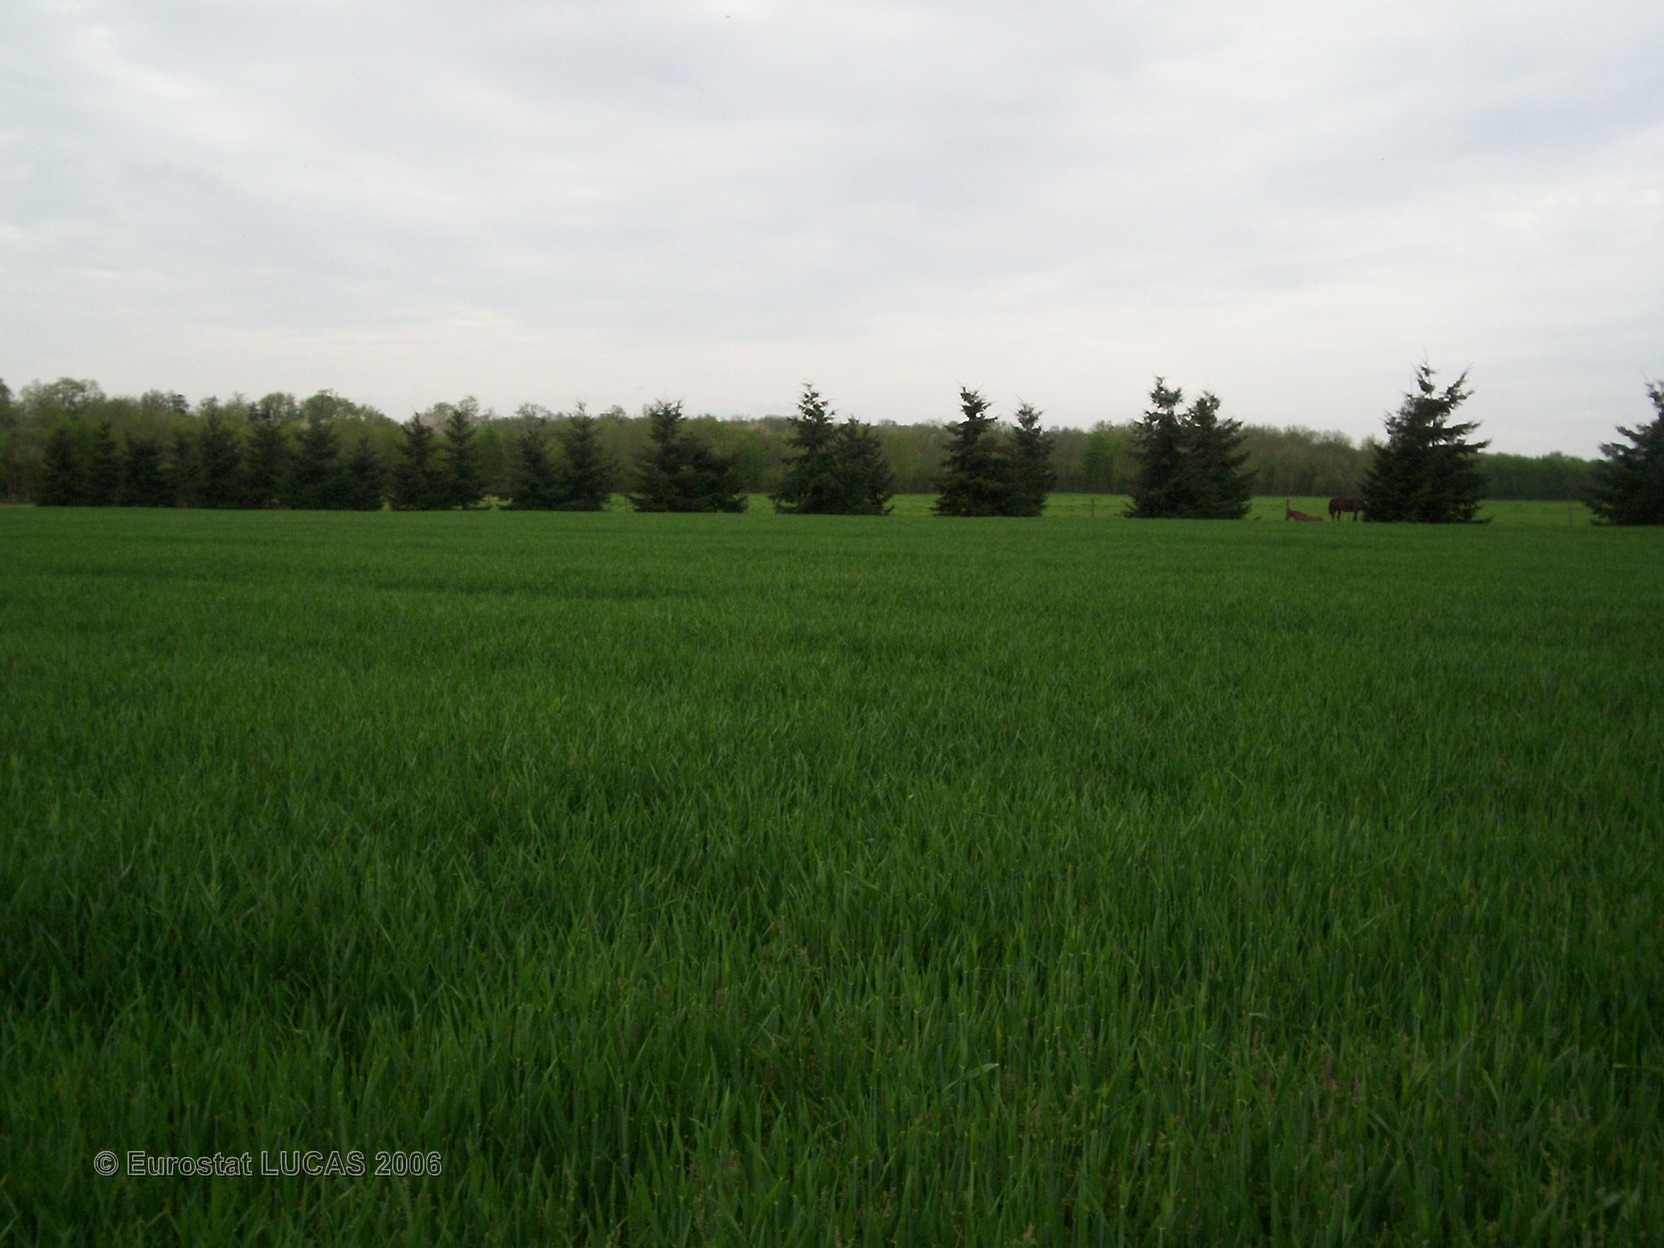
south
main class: Cropland
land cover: Barley
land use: Agriculture (excluding fallow land and kitchen gardens)
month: May
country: FR
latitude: 48.9080
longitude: 0.6020
